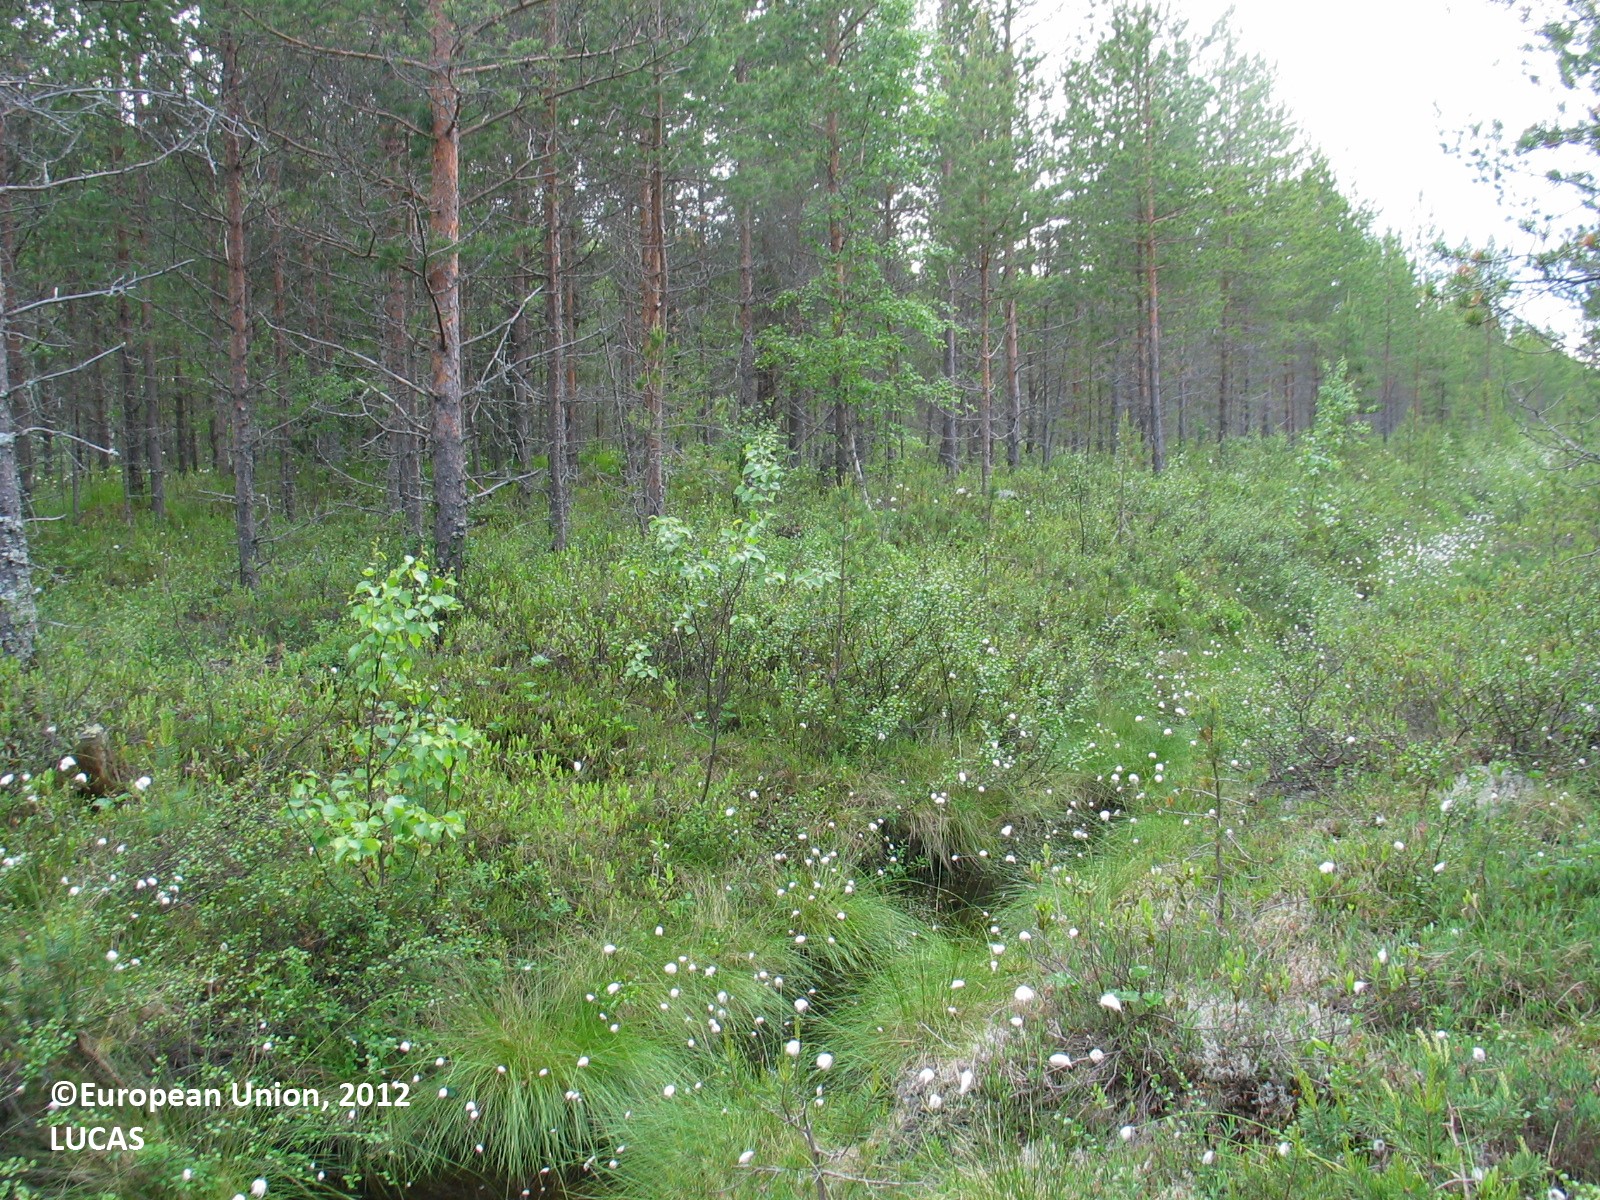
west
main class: Woodland
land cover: Pine dominated coniferous woodland
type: mire and swamp forests
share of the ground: 25 - 50 %
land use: Forestry
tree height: > 5 m
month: June
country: FI
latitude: 64.8725
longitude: 26.2062
